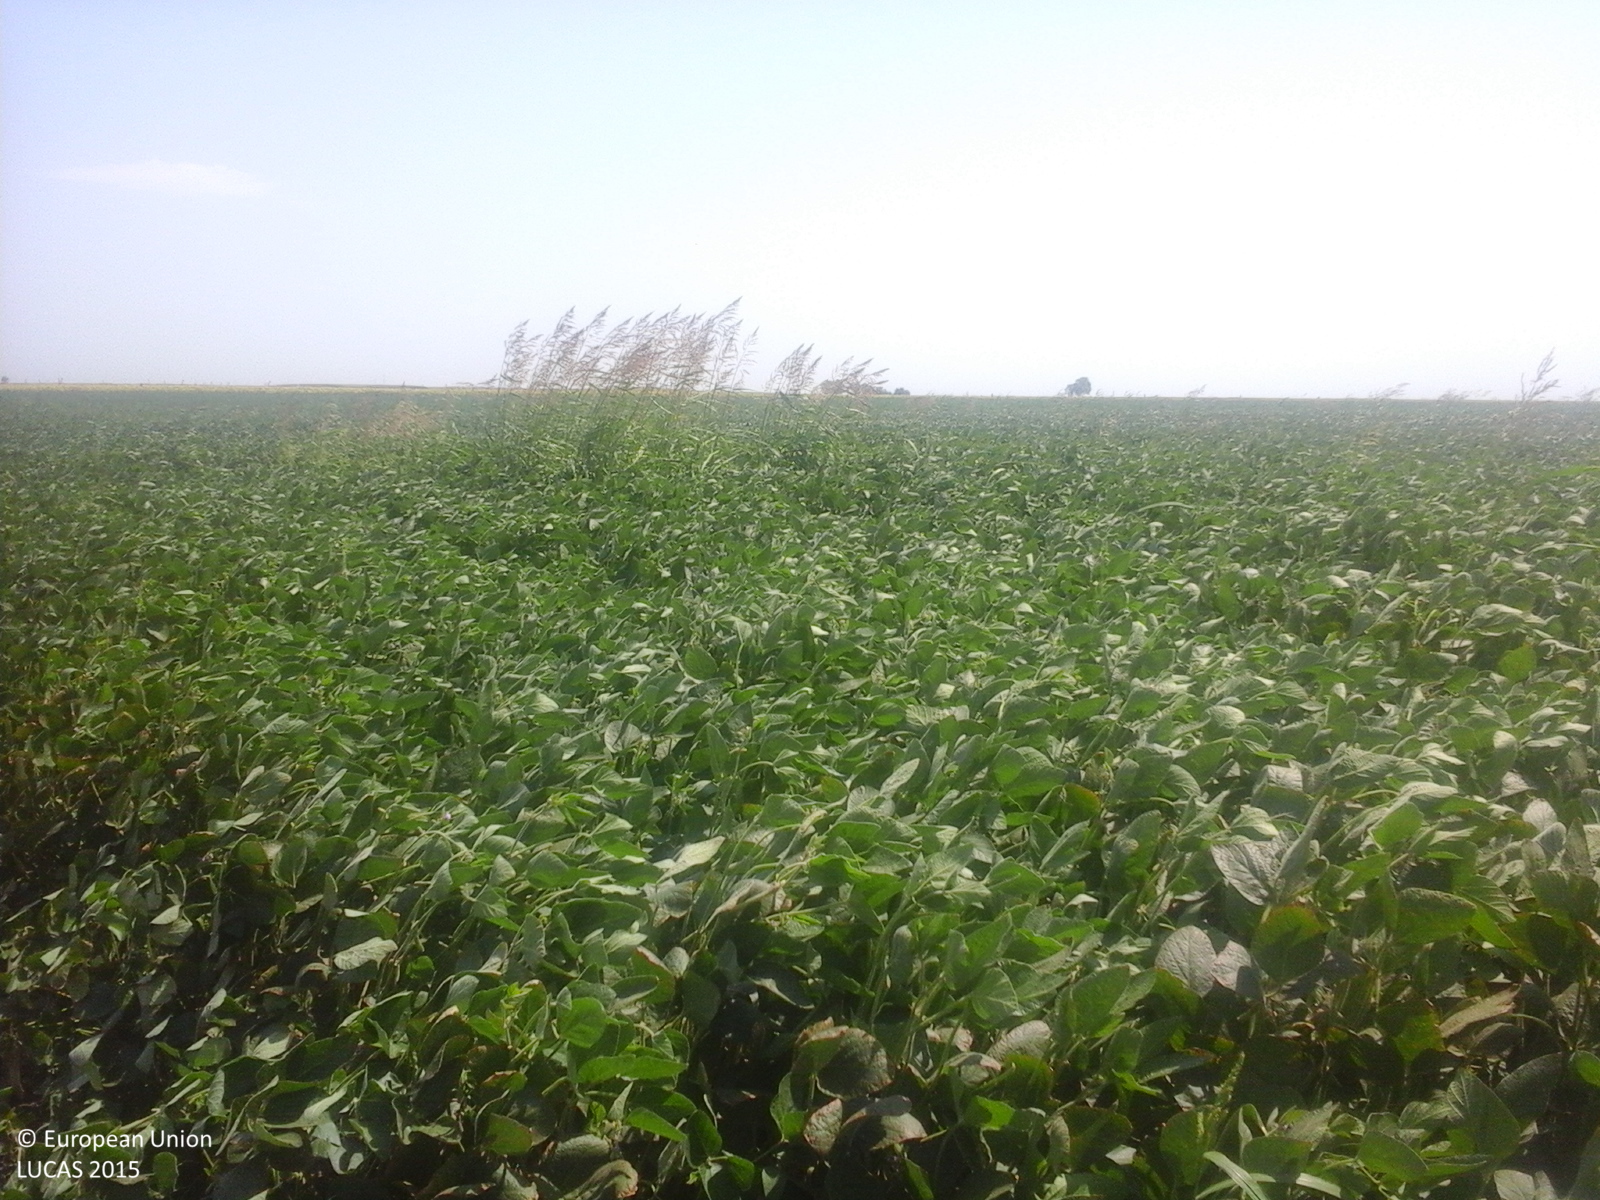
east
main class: Cropland
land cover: Soya
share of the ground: > 75 %
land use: Agriculture (excluding fallow land and kitchen gardens)
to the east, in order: Soya
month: August
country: RO
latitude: 45.1551
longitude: 27.6971
